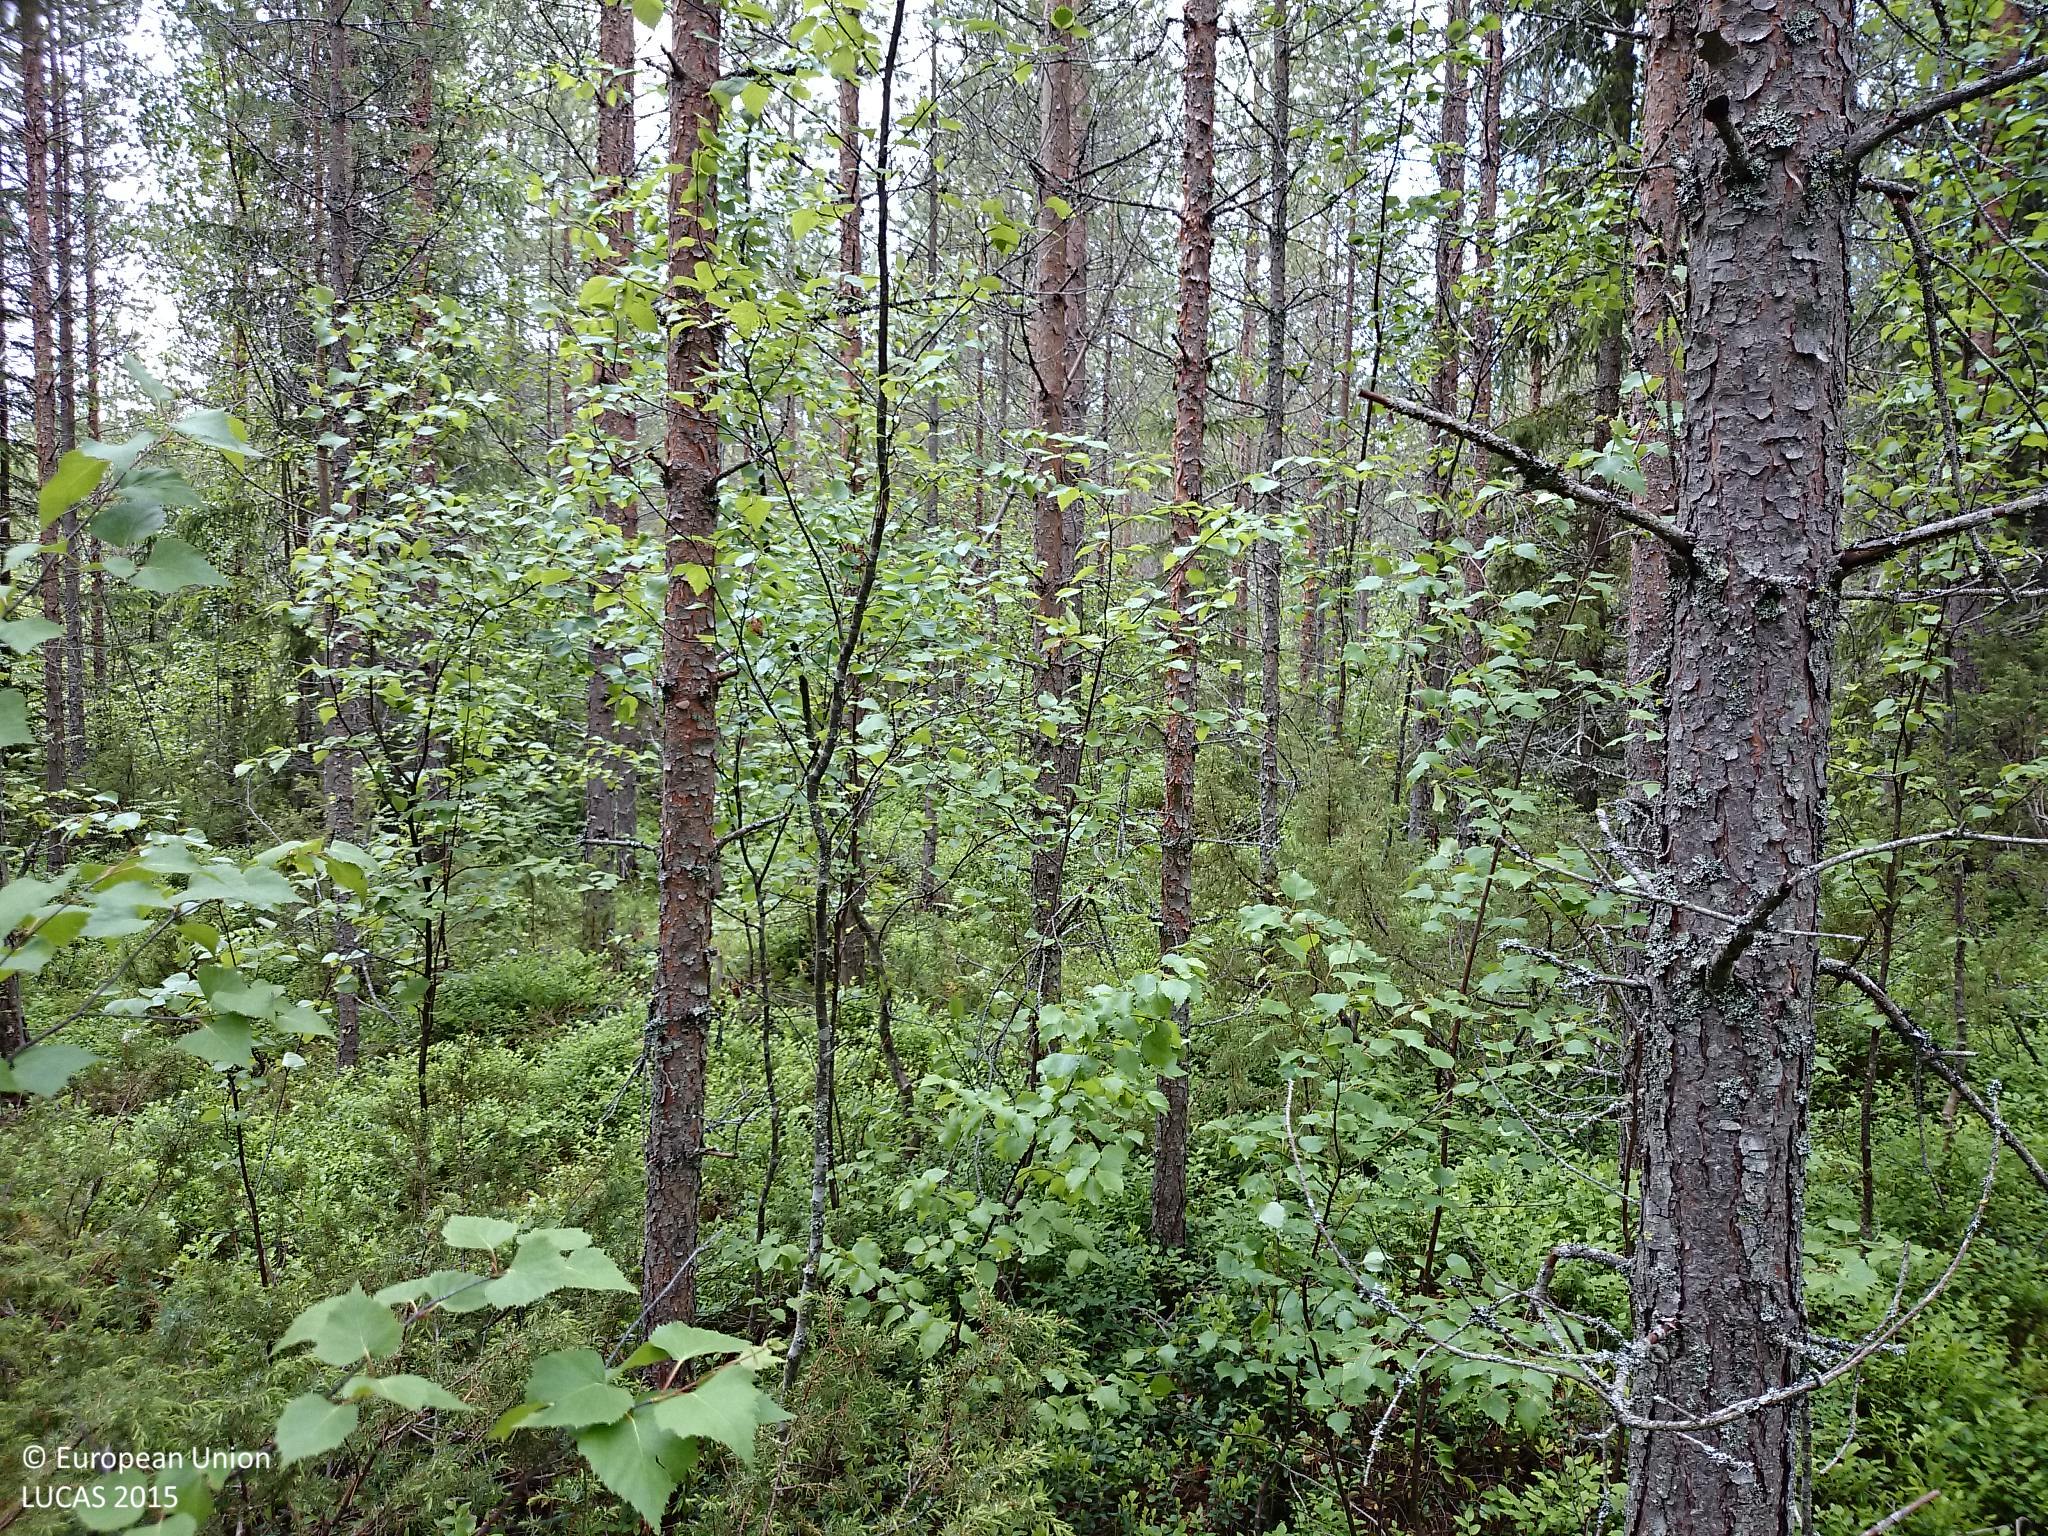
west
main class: Woodland
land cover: Pine dominated mixed woodland
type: boreal forest
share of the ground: > 75 %
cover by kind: coniferous forest trees 60 %, broadleaved forest trees 20 %, shrubs 20 %
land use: Forestry
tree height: > 5 m
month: June
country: SE
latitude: 64.1404
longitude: 20.7708
